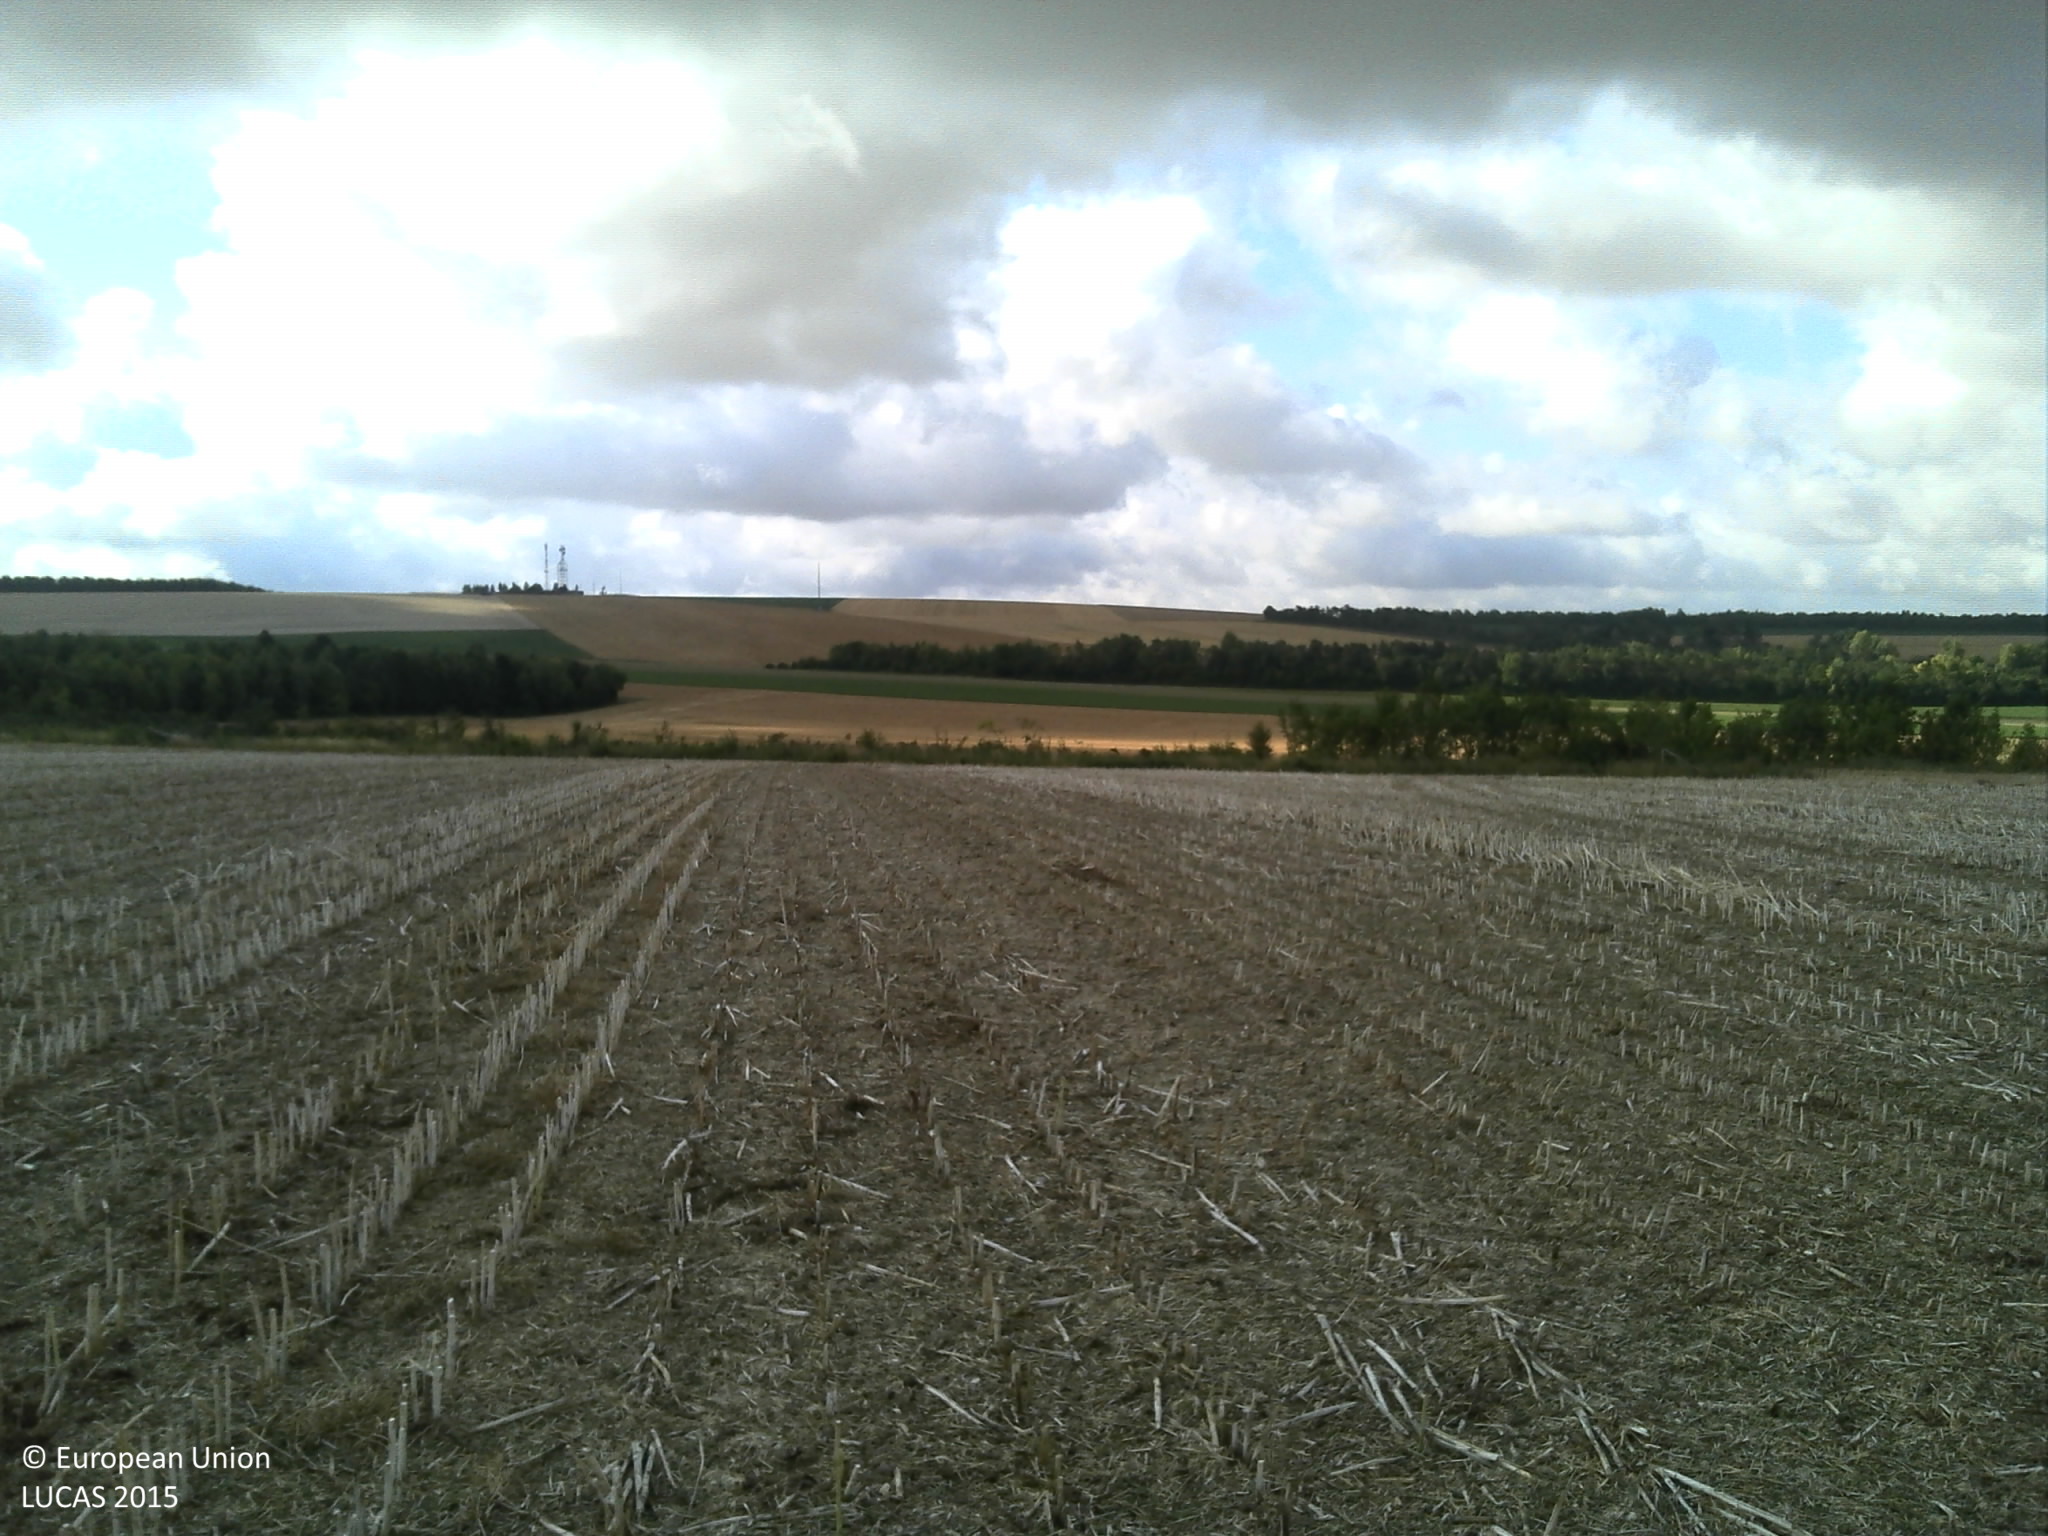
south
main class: Cropland
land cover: Rape and turnip rape
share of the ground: 25 - 50 %
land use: Agriculture (excluding fallow land and kitchen gardens)
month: July
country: FR
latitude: 49.2949
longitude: 4.5100
